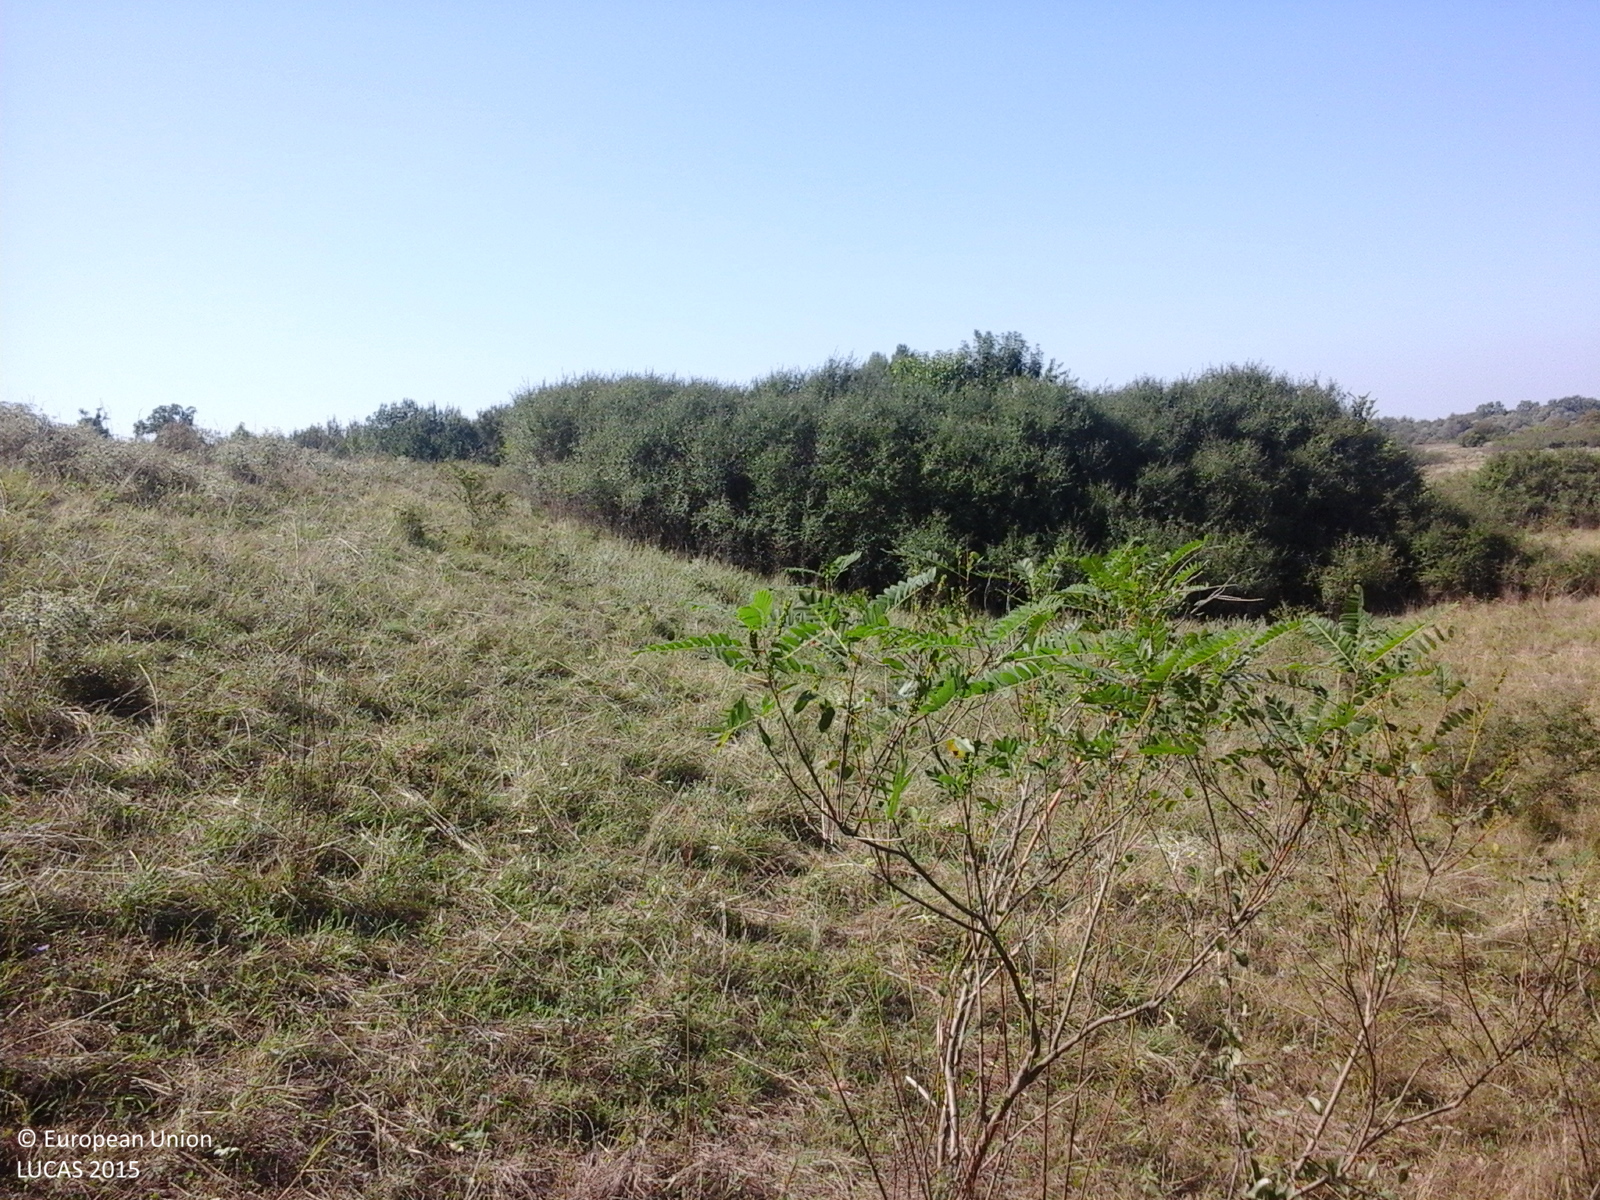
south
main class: Shrubland
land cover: Shrubland with sparse tree cover
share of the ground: > 75 %
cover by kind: shrubs 95 %, broadleaved forest trees 5 %
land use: Semi-natural and natural areas not in use
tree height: < 5 m
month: August
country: RO
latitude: 45.6609
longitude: 21.2863
